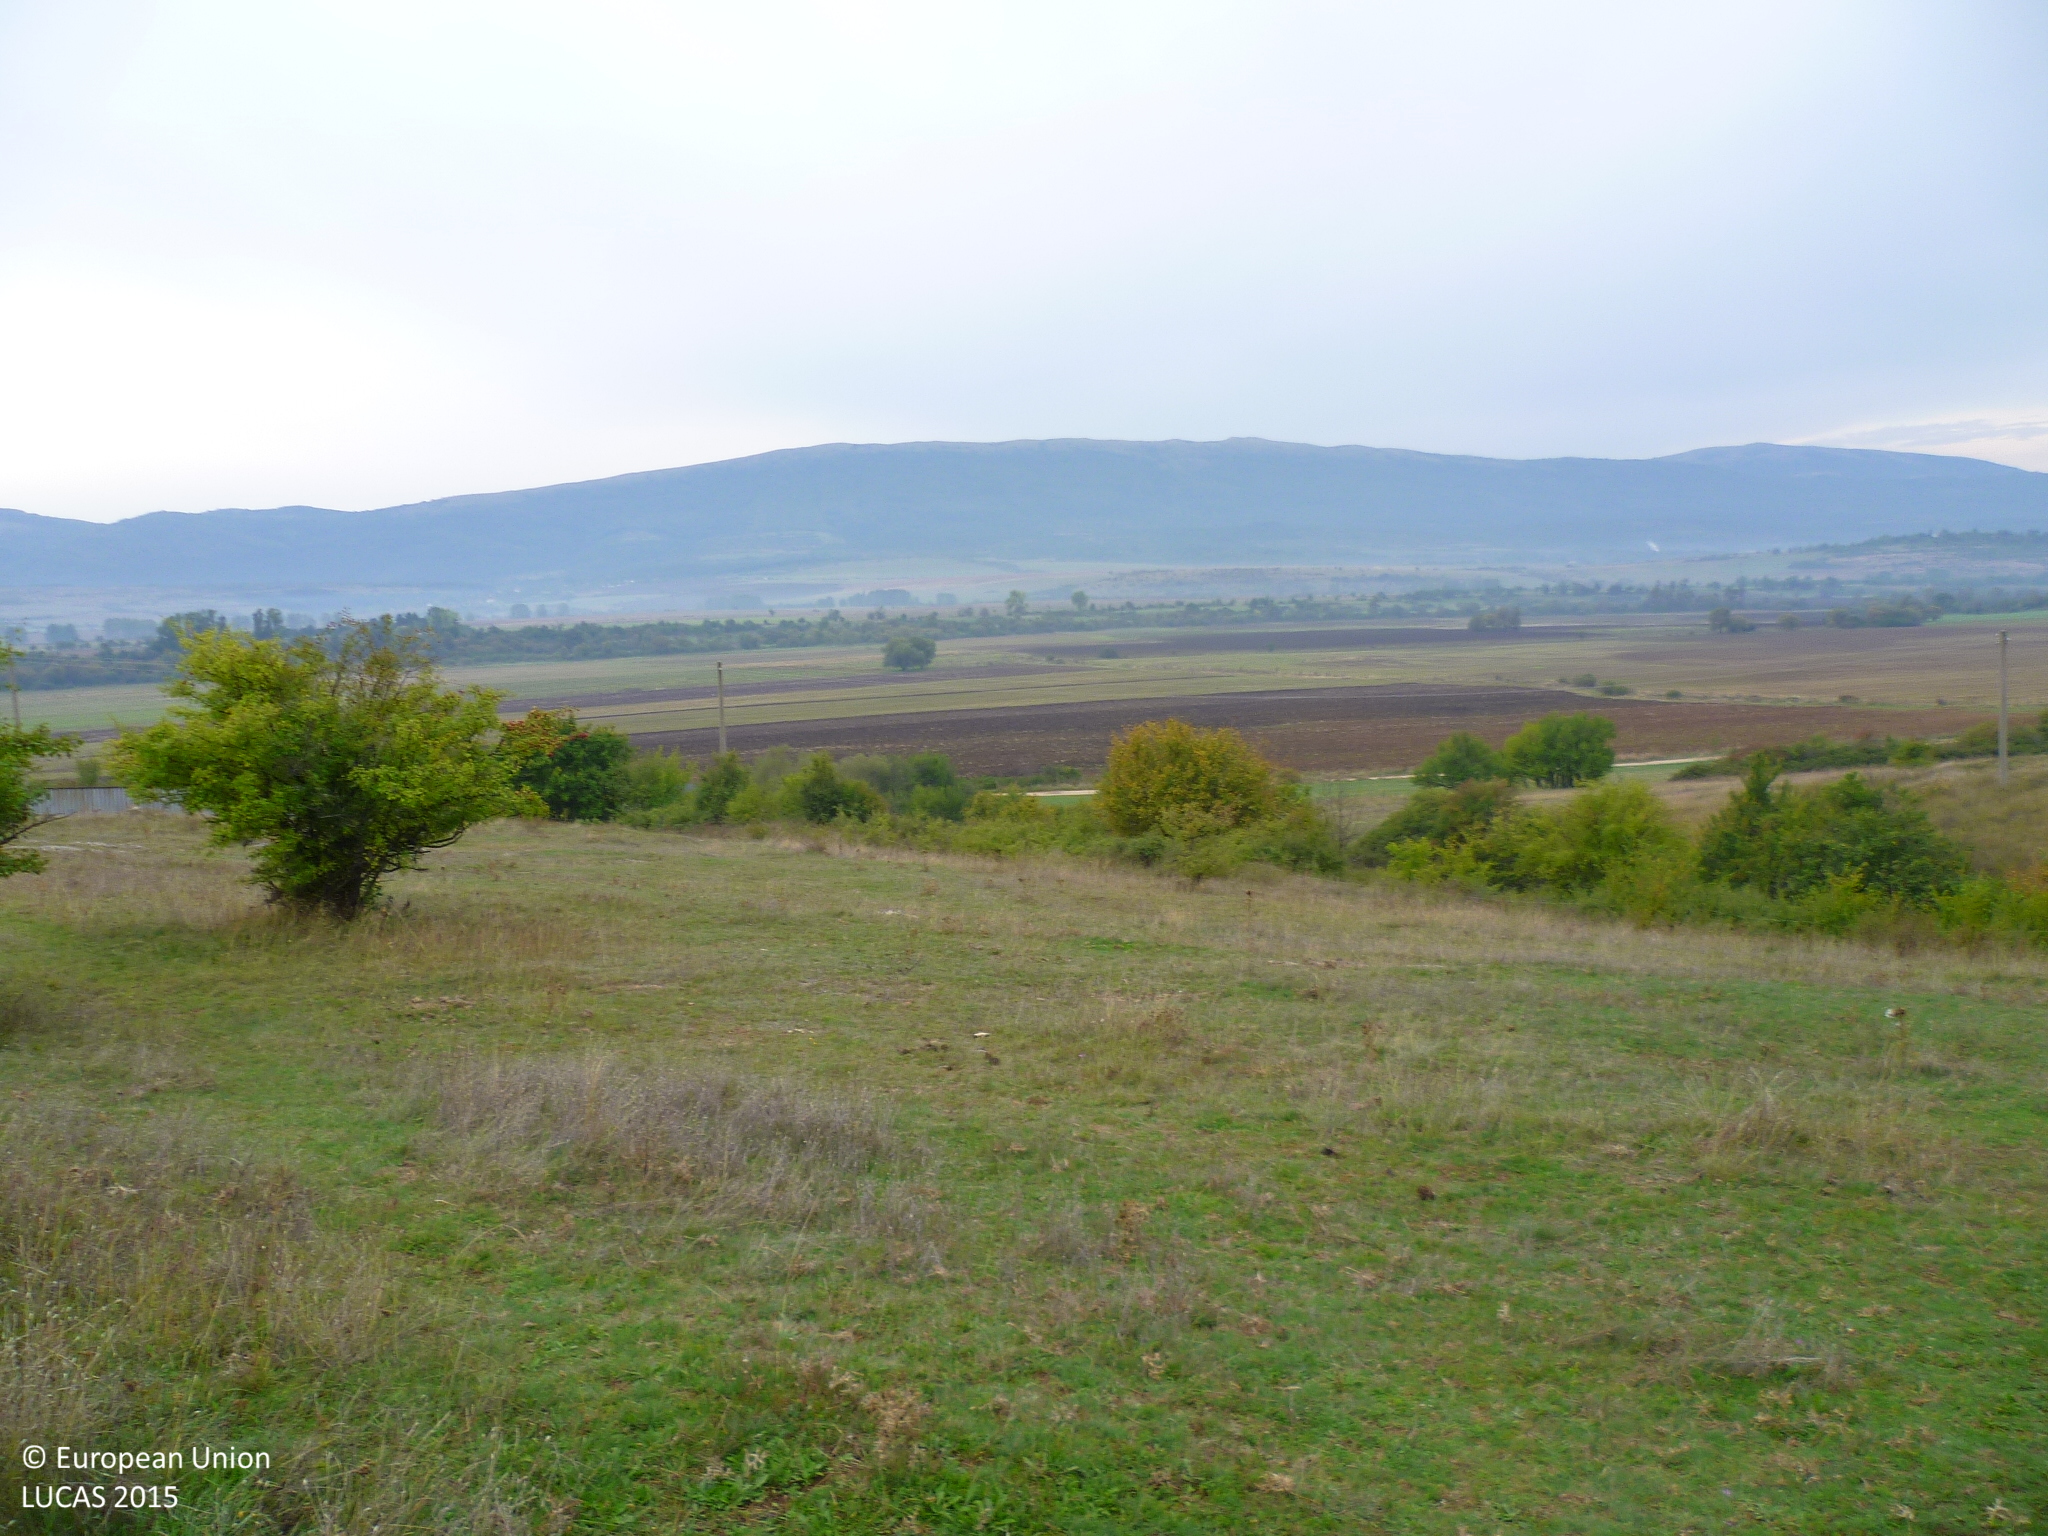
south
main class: Grassland
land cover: Grassland without tree/shrub cover
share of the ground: > 75 %
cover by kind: herbaceous plants 100 %
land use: Agriculture (excluding fallow land and kitchen gardens)
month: October
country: BG
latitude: 43.0143
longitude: 23.0266
